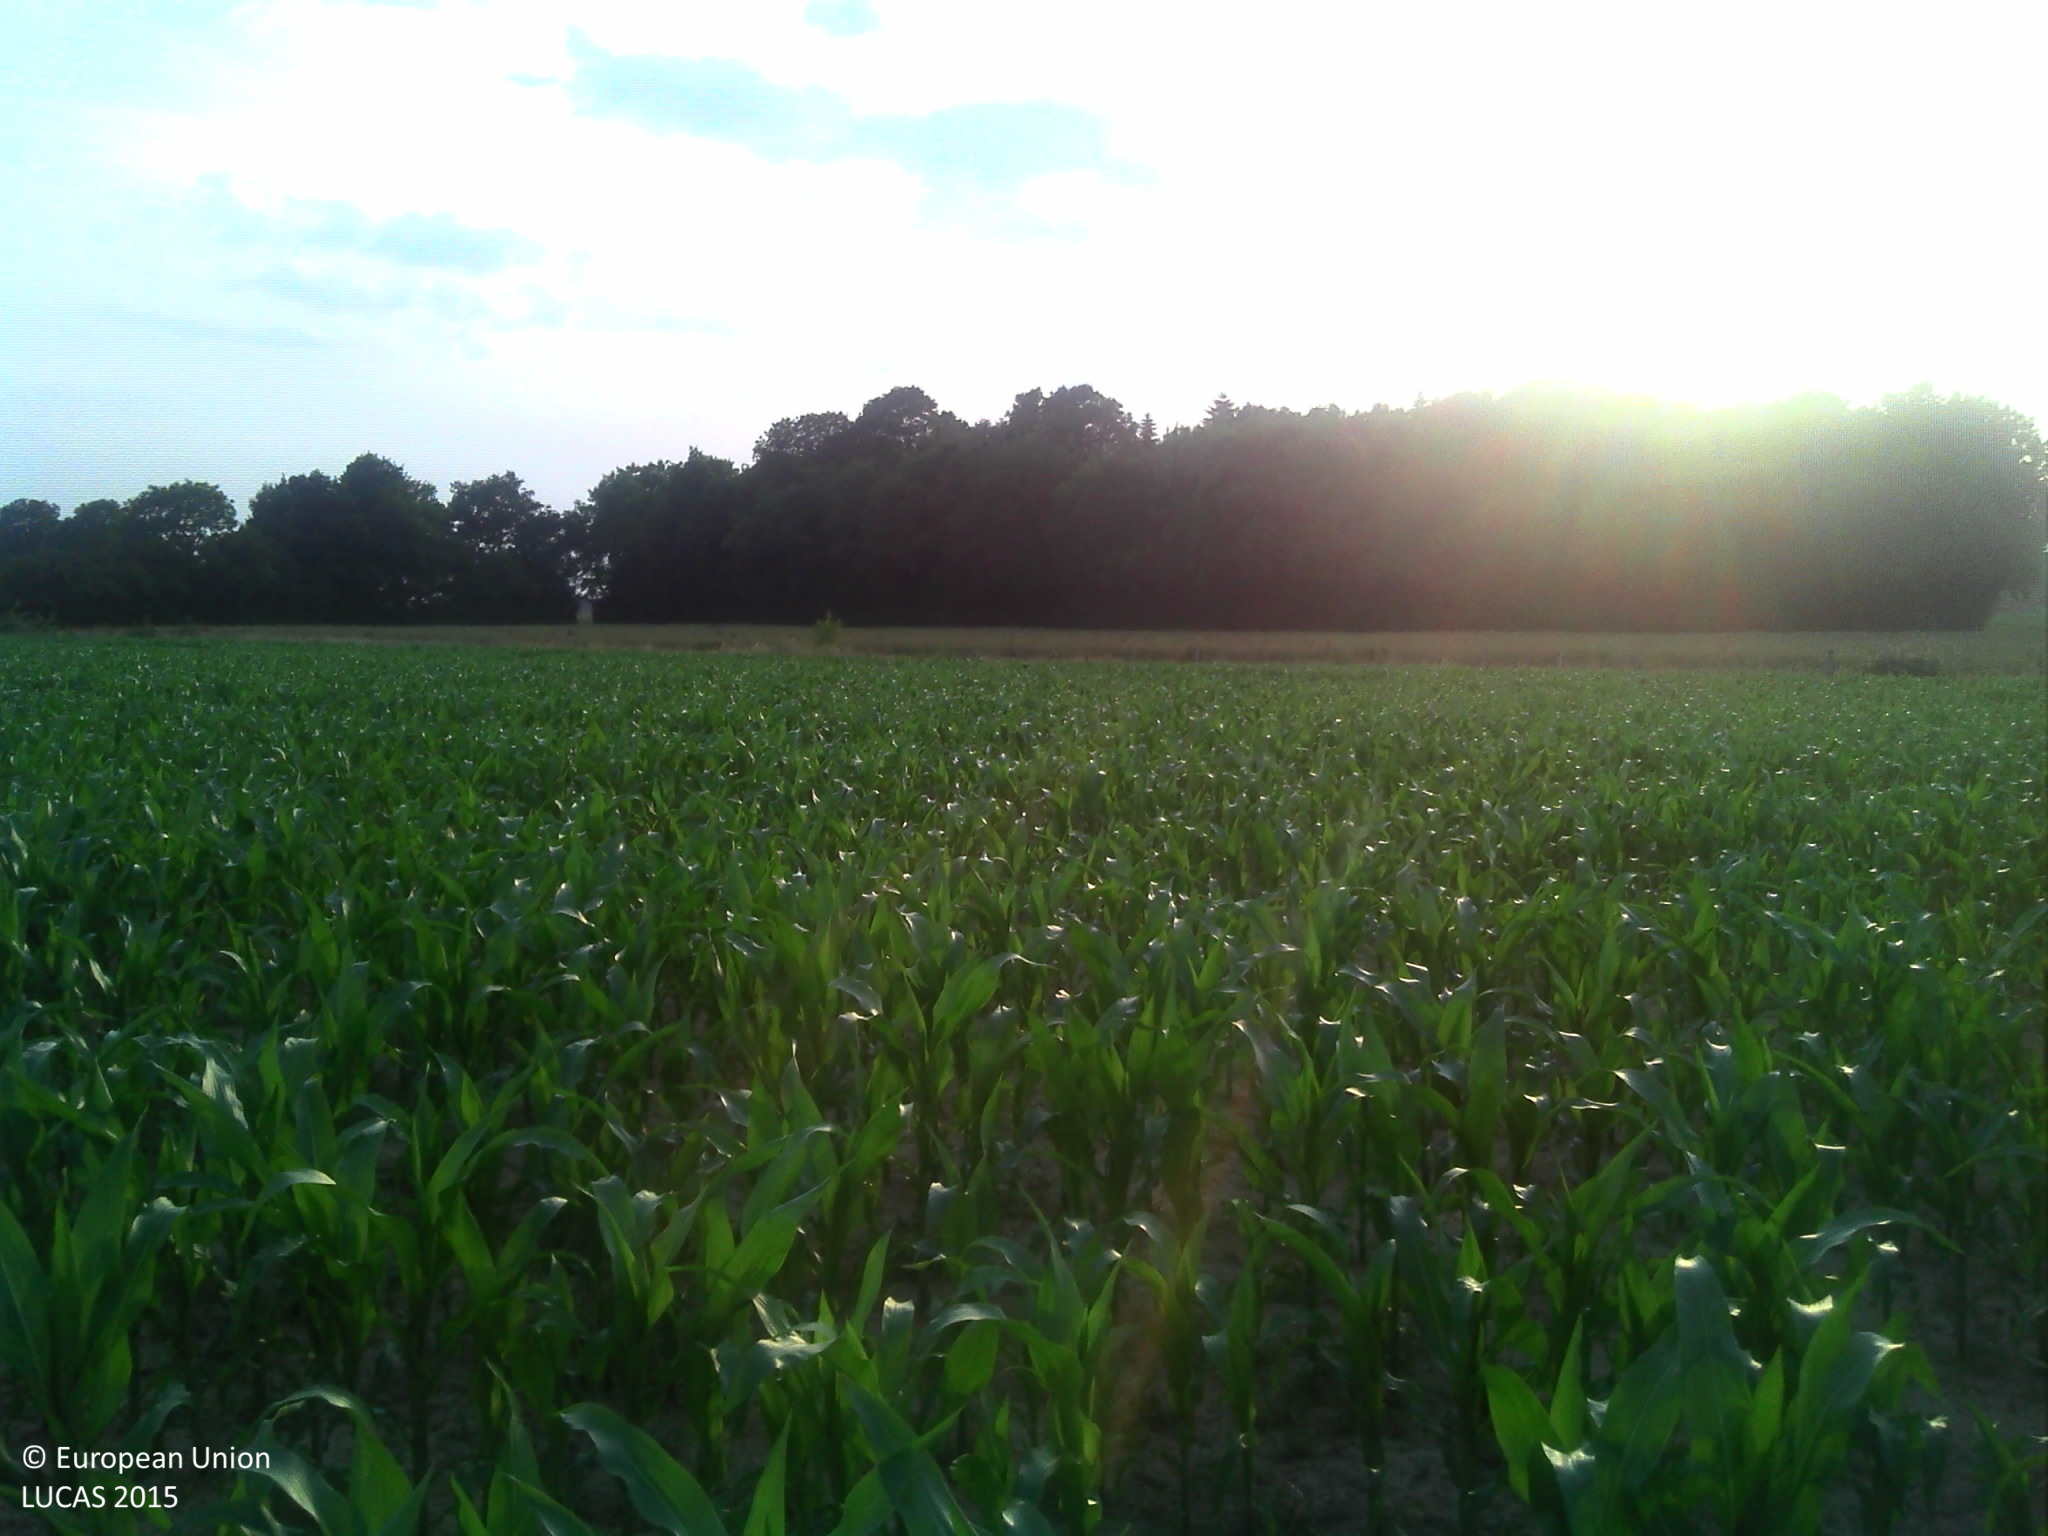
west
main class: Cropland
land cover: Maize
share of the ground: 50 - 75 %
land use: Agriculture (excluding fallow land and kitchen gardens)
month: July
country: FR
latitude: 48.8918
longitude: 0.4124
